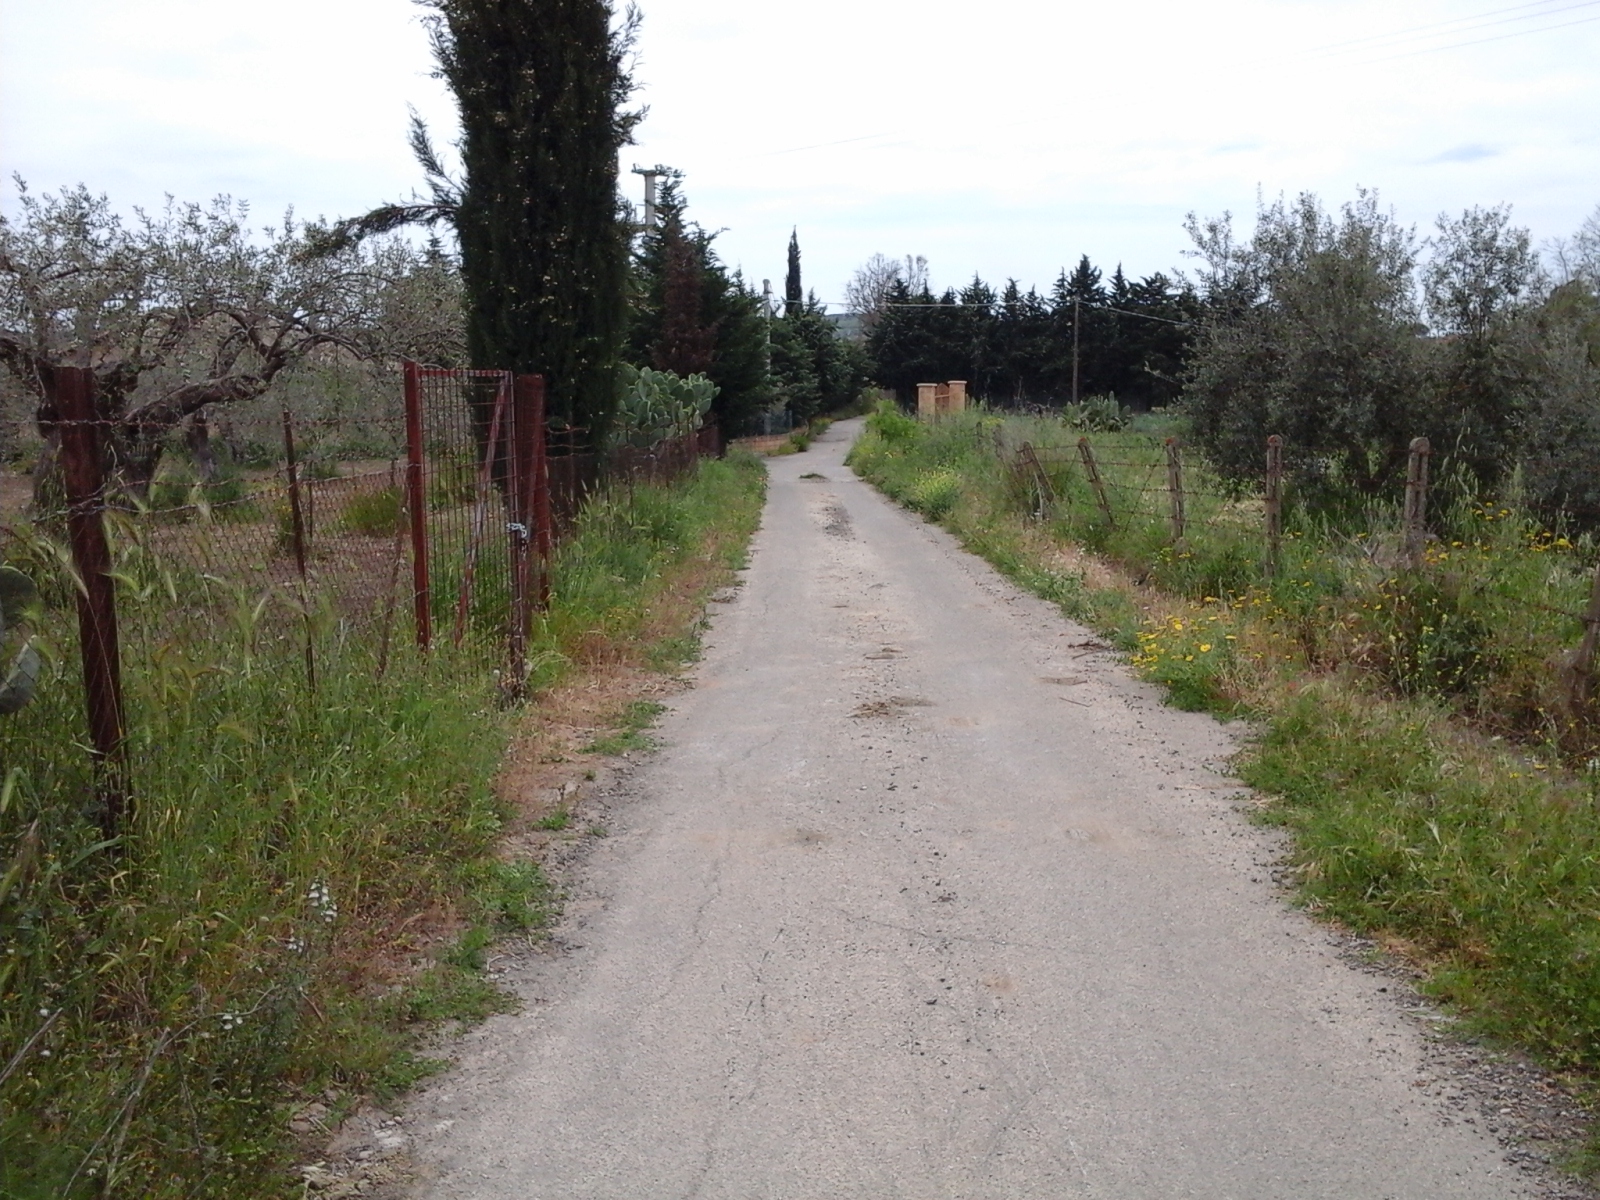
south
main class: Cropland
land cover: Olive groves
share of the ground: 50 - 75 %
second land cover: Other bare soil
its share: > 75 %
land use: Agriculture (excluding fallow land and kitchen gardens)
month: May
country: IT
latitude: 37.4192
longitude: 14.1831
